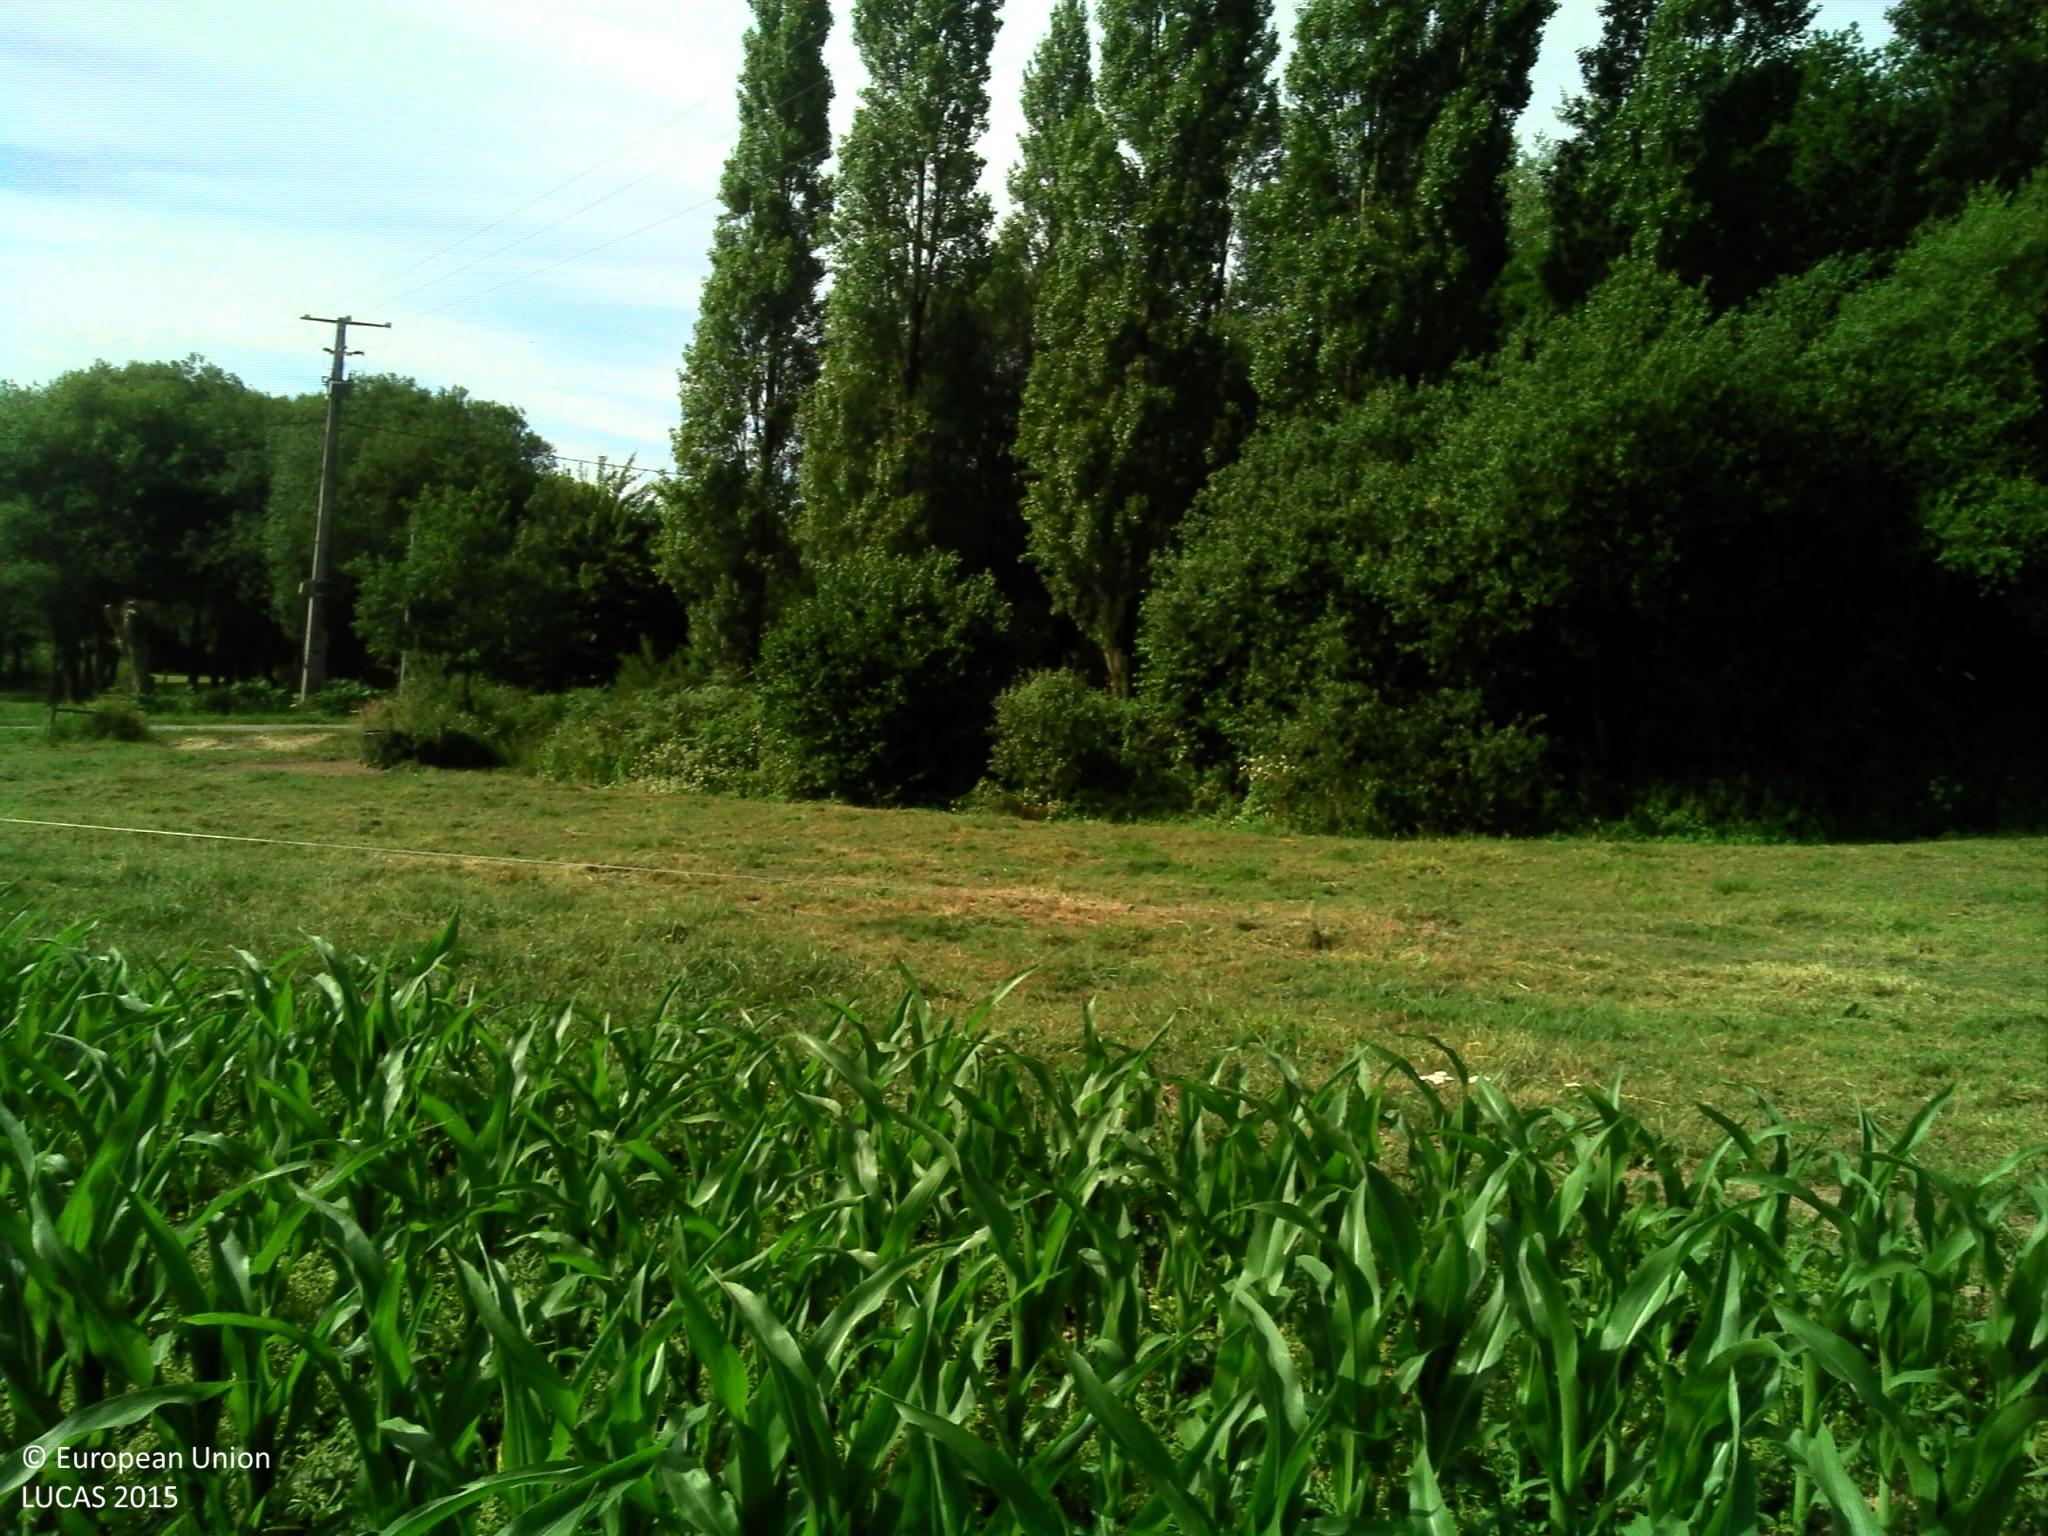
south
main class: Cropland
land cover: Maize
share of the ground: > 75 %
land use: Agriculture (excluding fallow land and kitchen gardens)
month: June
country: FR
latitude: 47.9612
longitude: -2.0388
